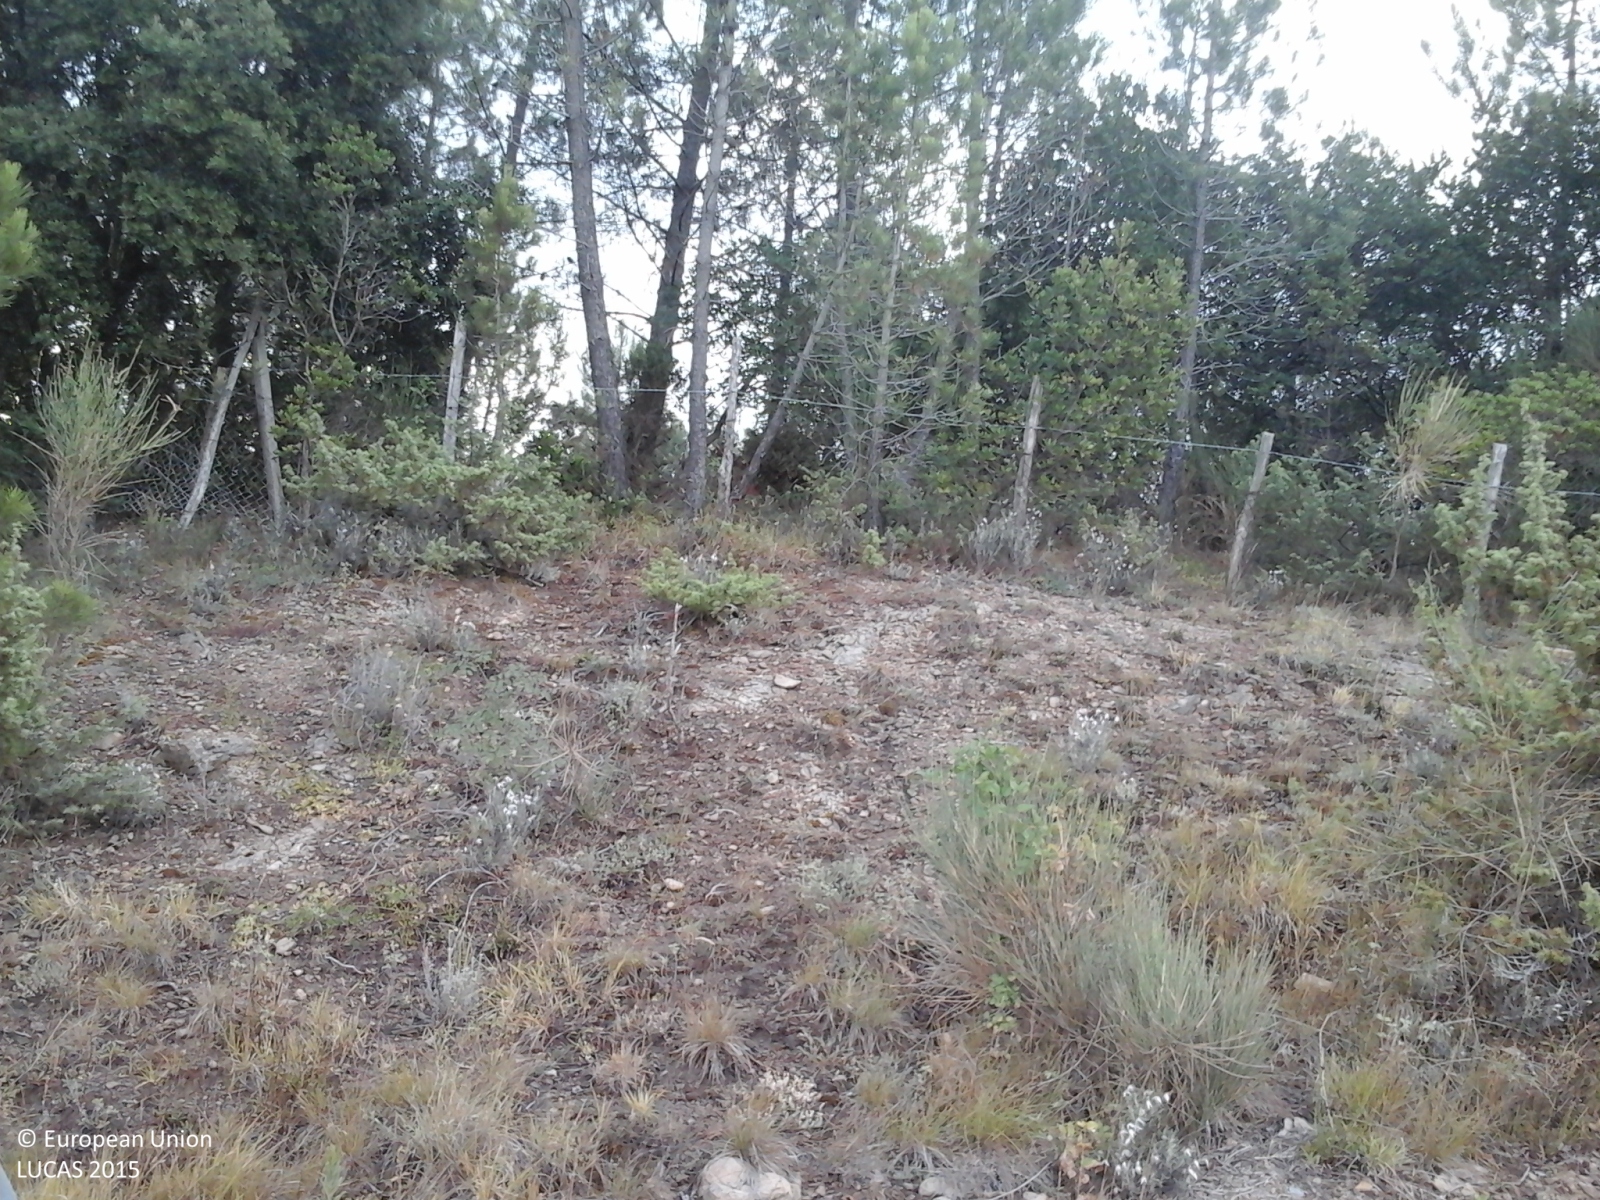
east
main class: Woodland
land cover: Other mixed woodland
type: thermophilous deciduous forest
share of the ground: > 75 %
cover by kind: broadleaved forest trees 60 %, coniferous forest trees 40 %
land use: Forestry
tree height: > 5 m
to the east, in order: Other mixed woodland; Electric lines; Other mixed woodland; Grass margins; Paved roads, cycling and walking lanes; Grass margins; Electric lines; Paved roads, cycling and walking lanes; Fences; Shrubland without tree cover
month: July
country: IT
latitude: 43.4804
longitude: 10.9246
